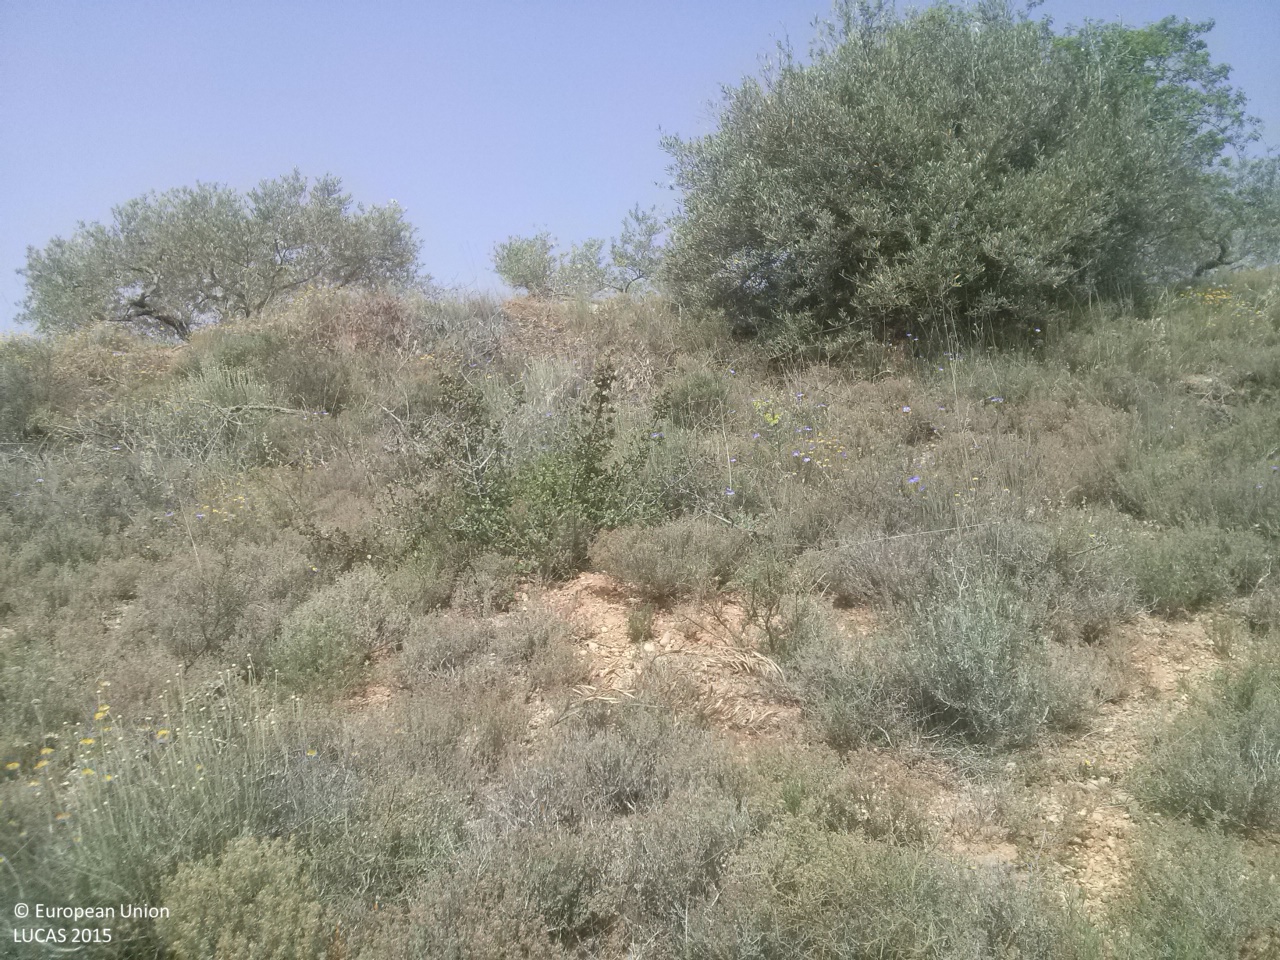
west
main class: Cropland
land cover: Olive groves
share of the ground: 10 - 25 %
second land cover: Shrubland without tree cover
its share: > 75 %
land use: Abandoned areas
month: May
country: ES
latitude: 39.9720
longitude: -2.5347
